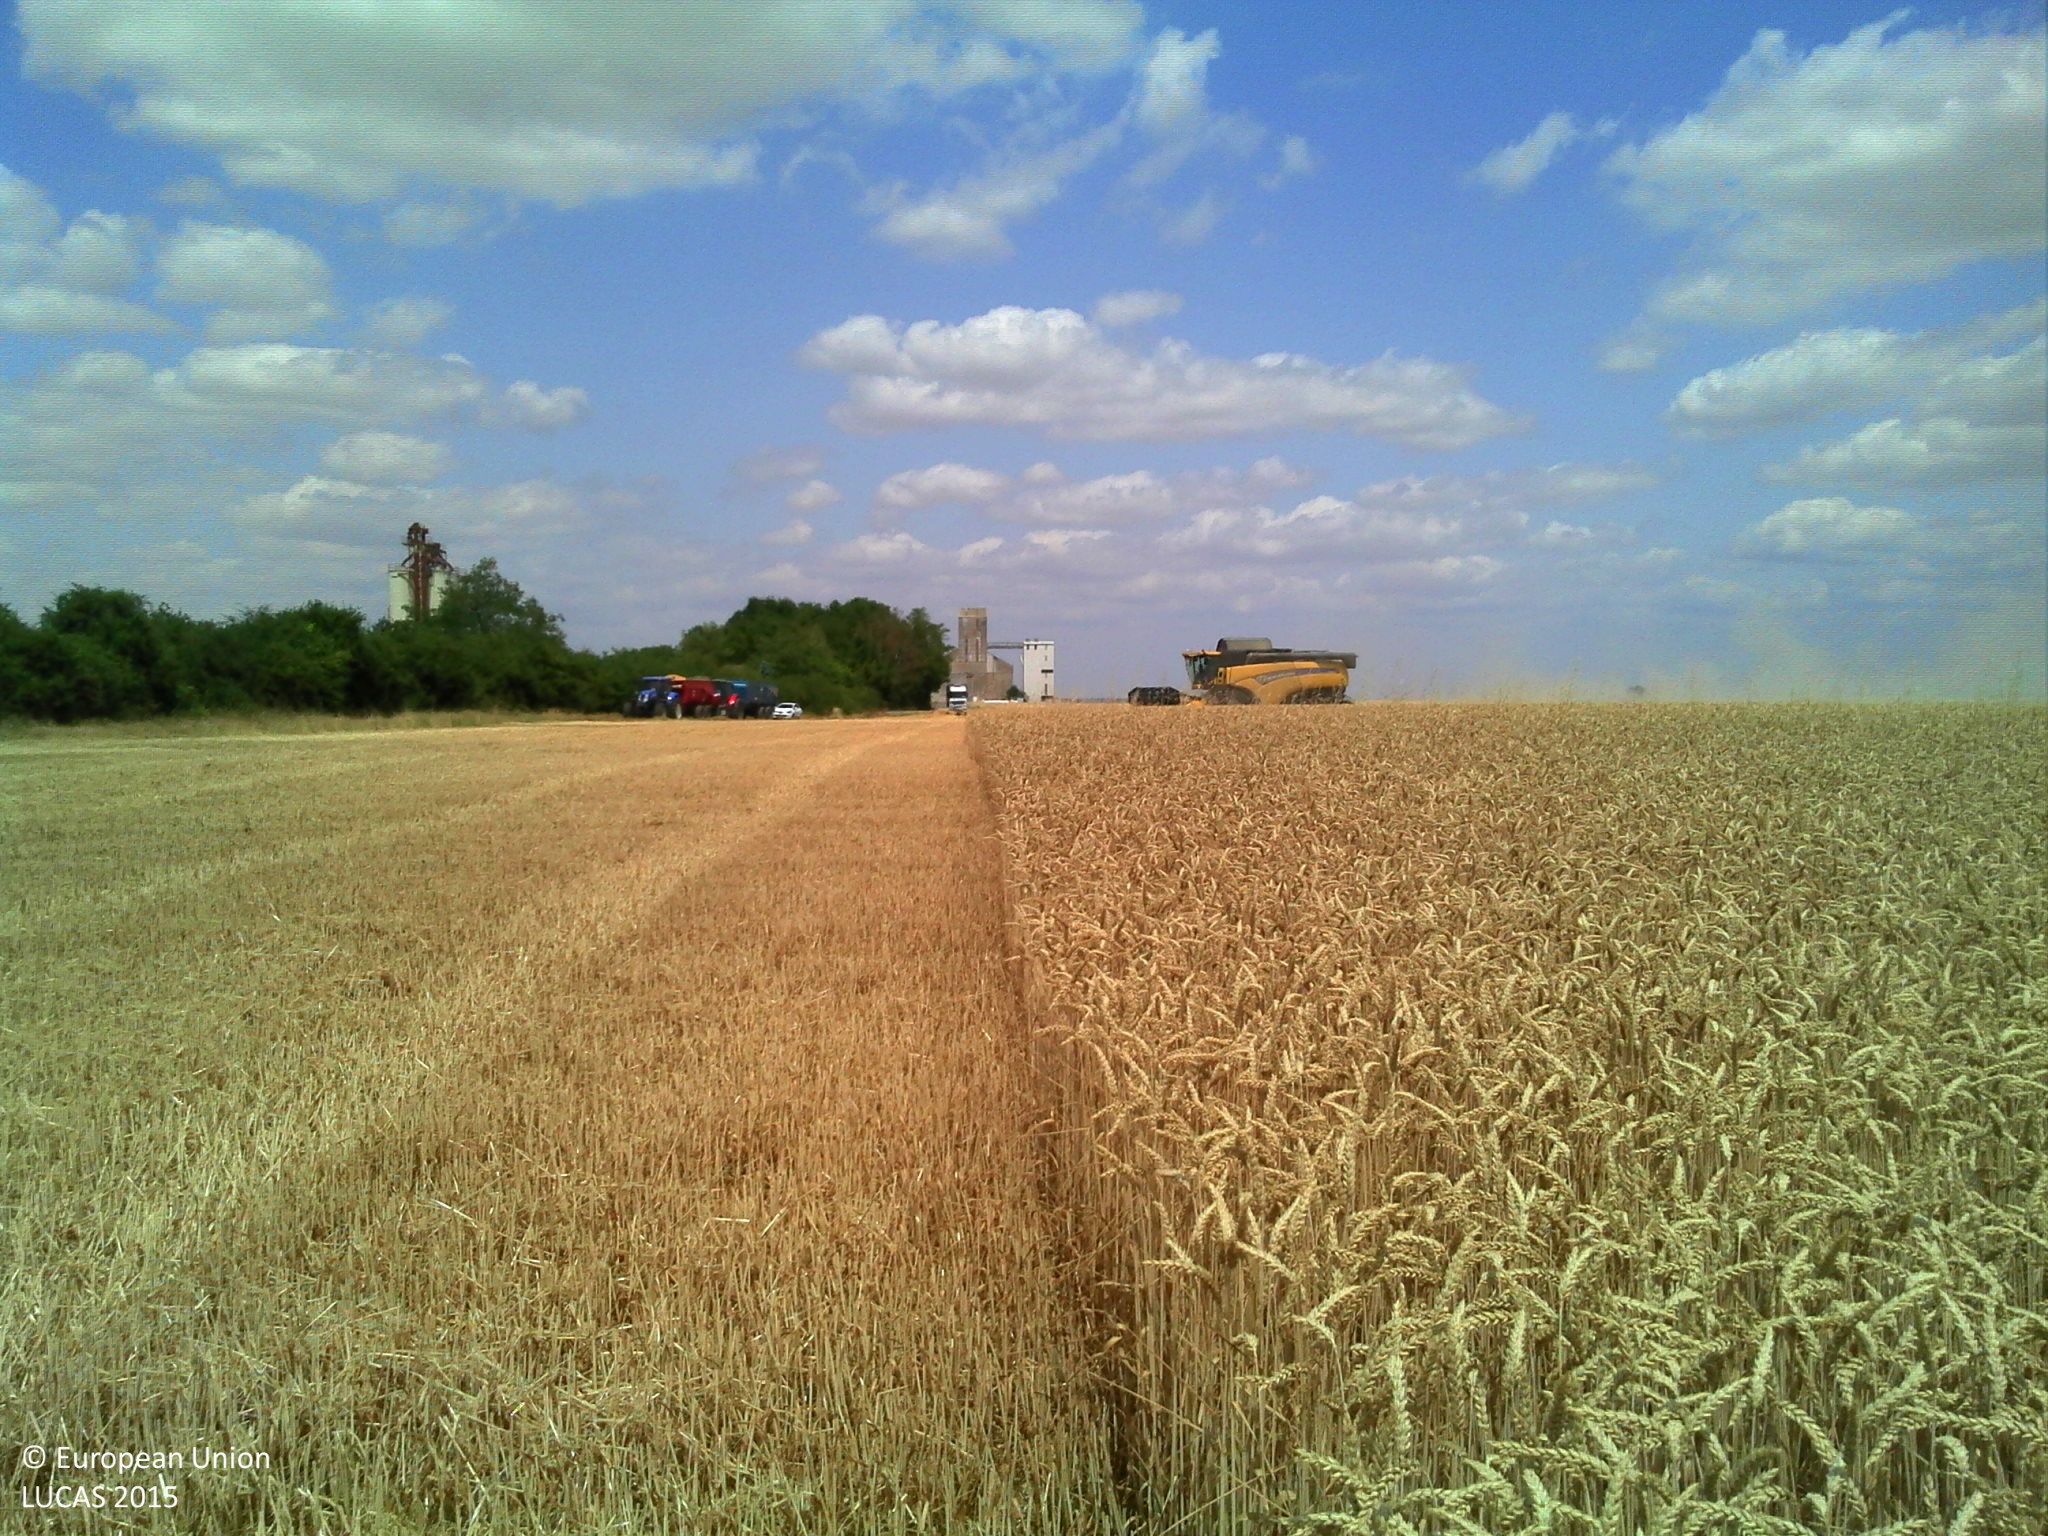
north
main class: Cropland
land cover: Common wheat
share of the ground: > 75 %
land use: Agriculture (excluding fallow land and kitchen gardens)
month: July
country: FR
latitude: 48.0933
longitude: 2.4846
